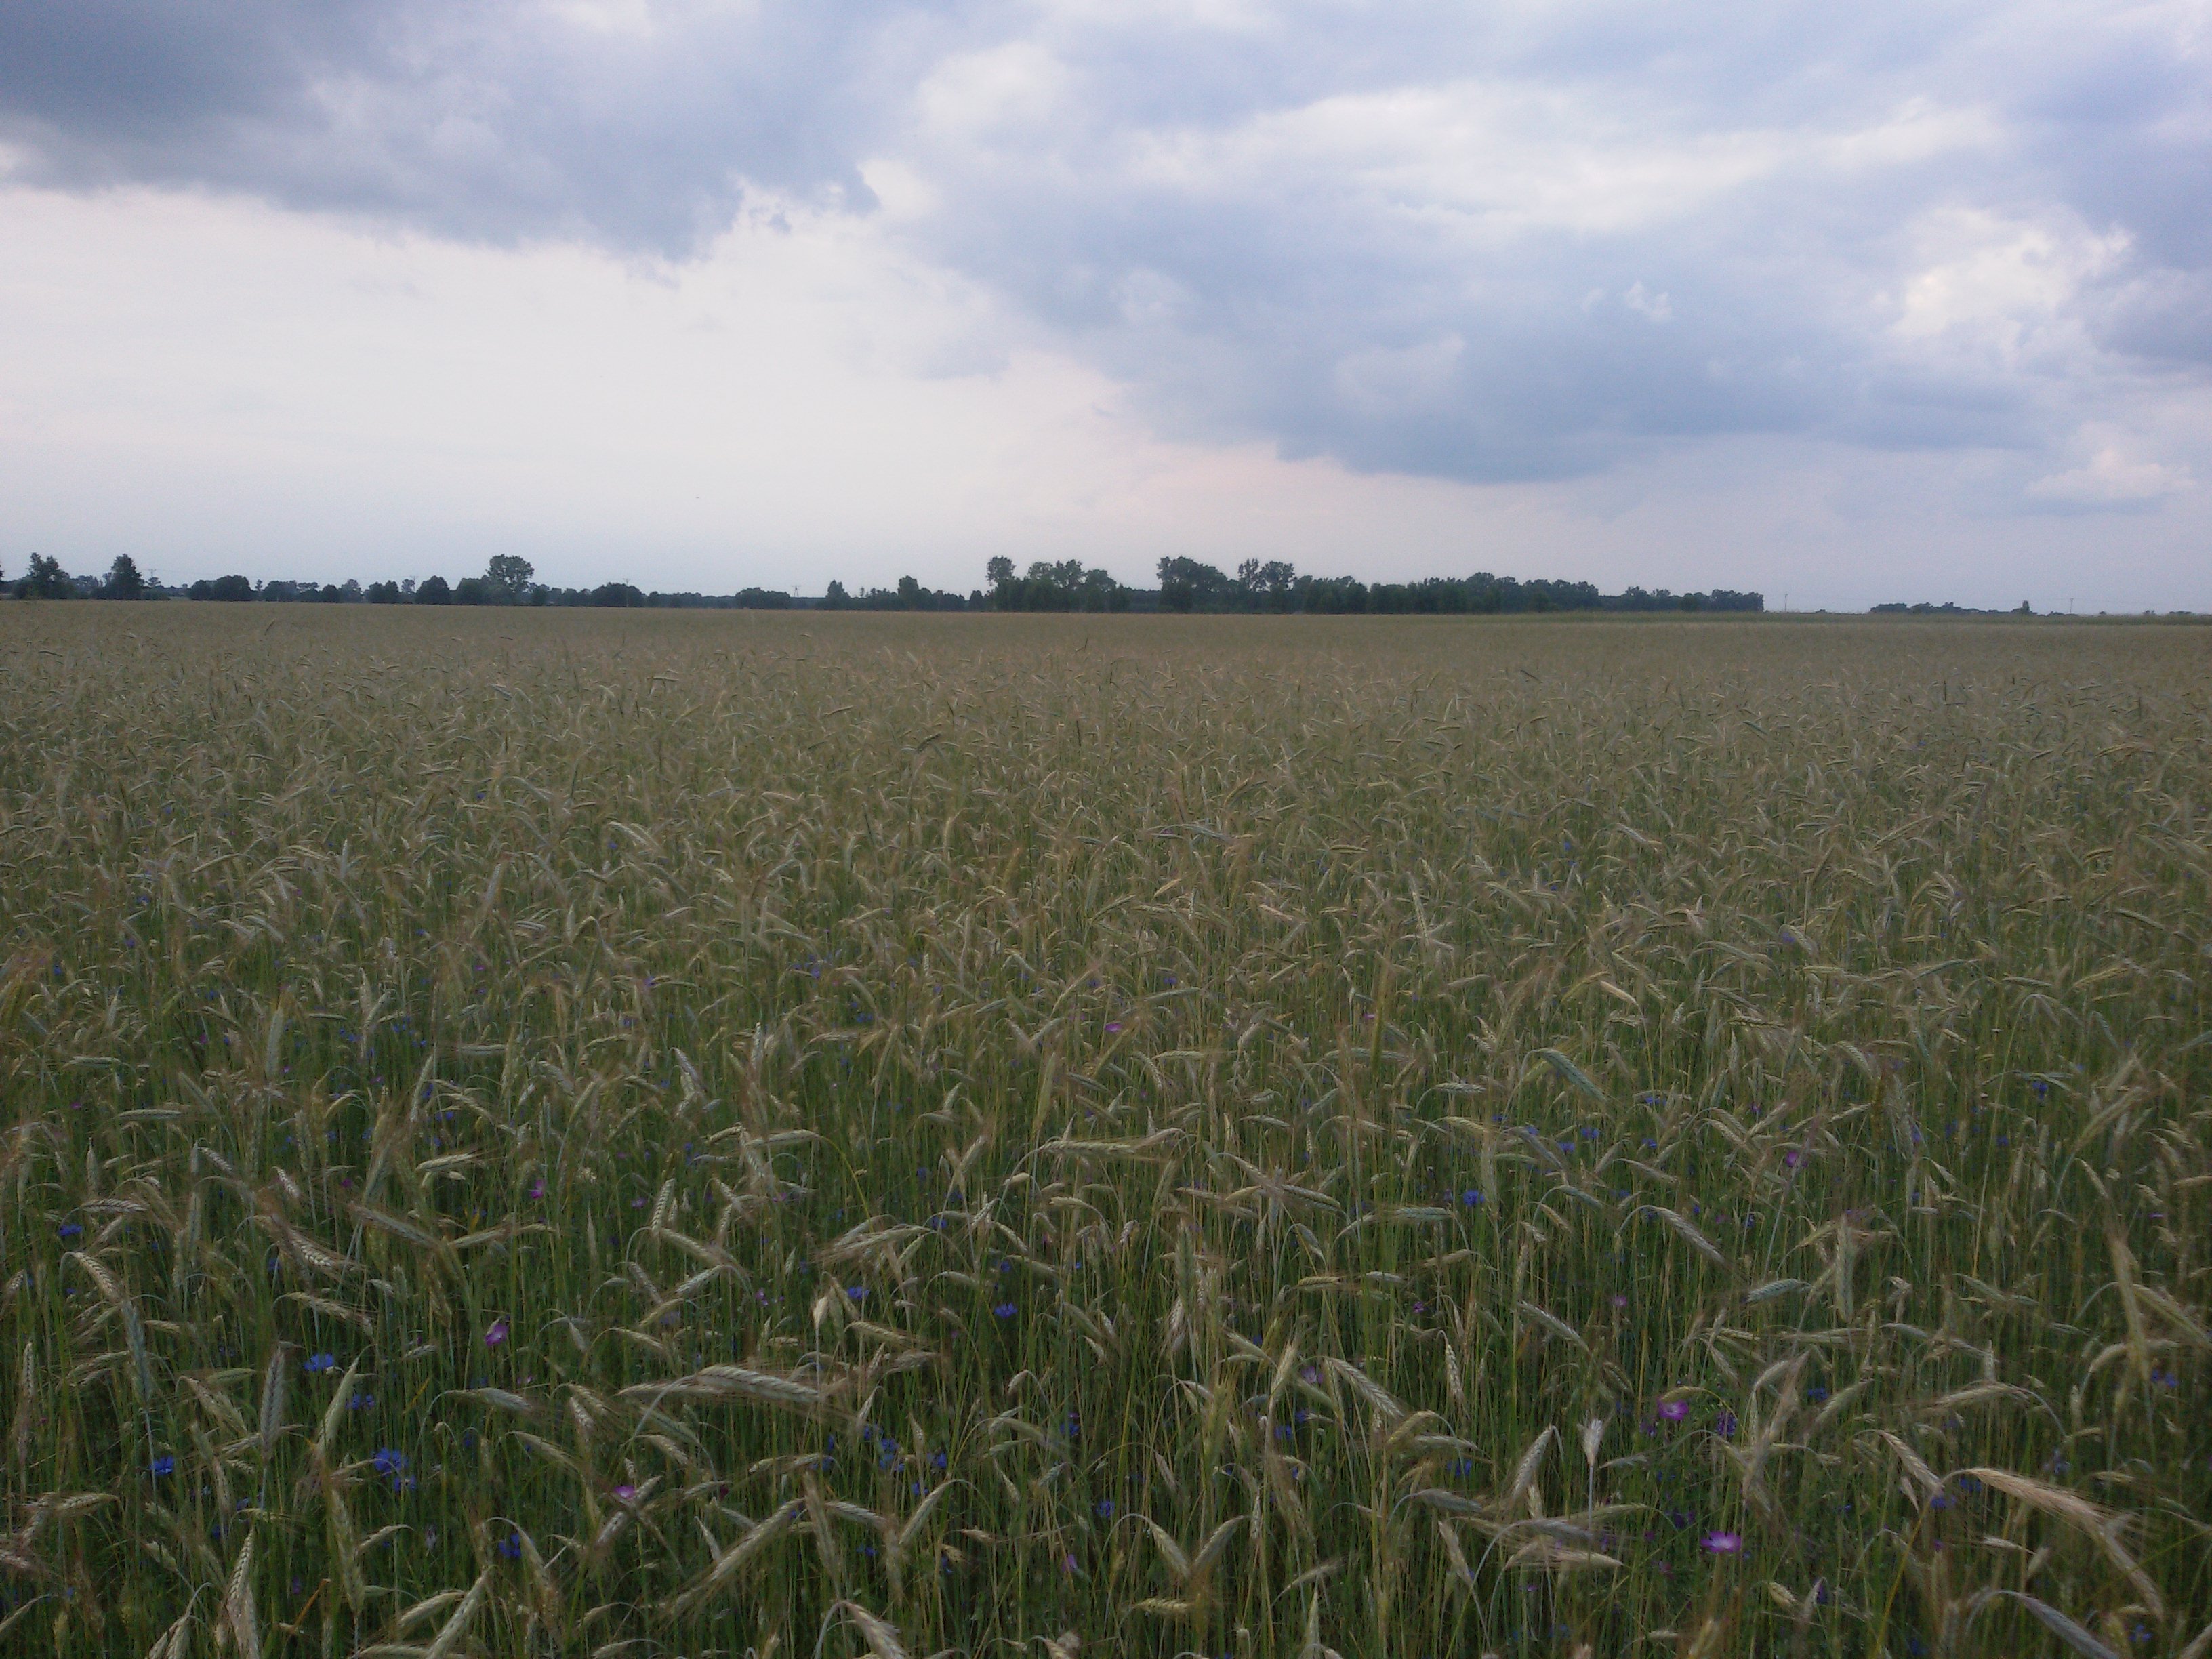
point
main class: Cropland
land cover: Rye
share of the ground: > 75 %
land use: Agriculture (excluding fallow land and kitchen gardens)
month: June
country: PL
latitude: 51.7924
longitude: 23.5845
